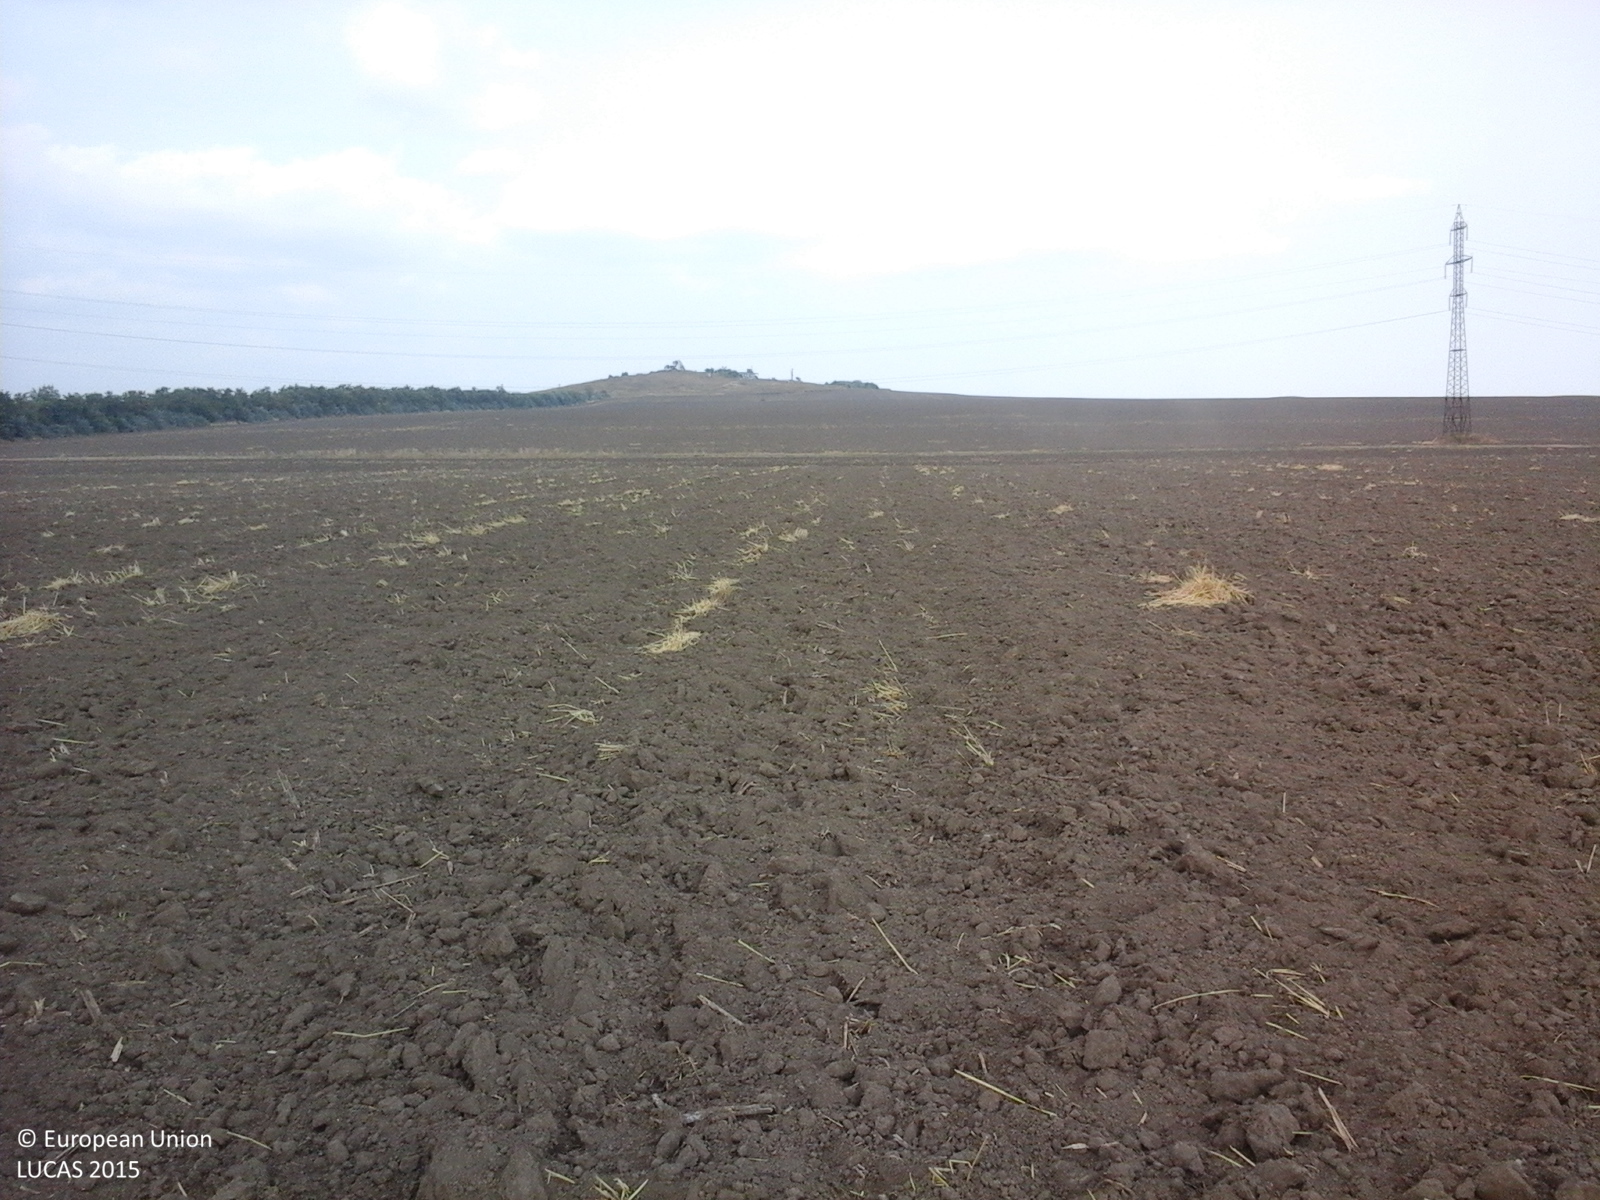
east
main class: Cropland
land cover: Common wheat
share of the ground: < 10 %
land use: Agriculture (excluding fallow land and kitchen gardens)
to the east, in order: Common wheat; Grass margins; Tracks; Common wheat; Electric lines; Common wheat
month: July
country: RO
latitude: 45.0589
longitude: 28.6626
